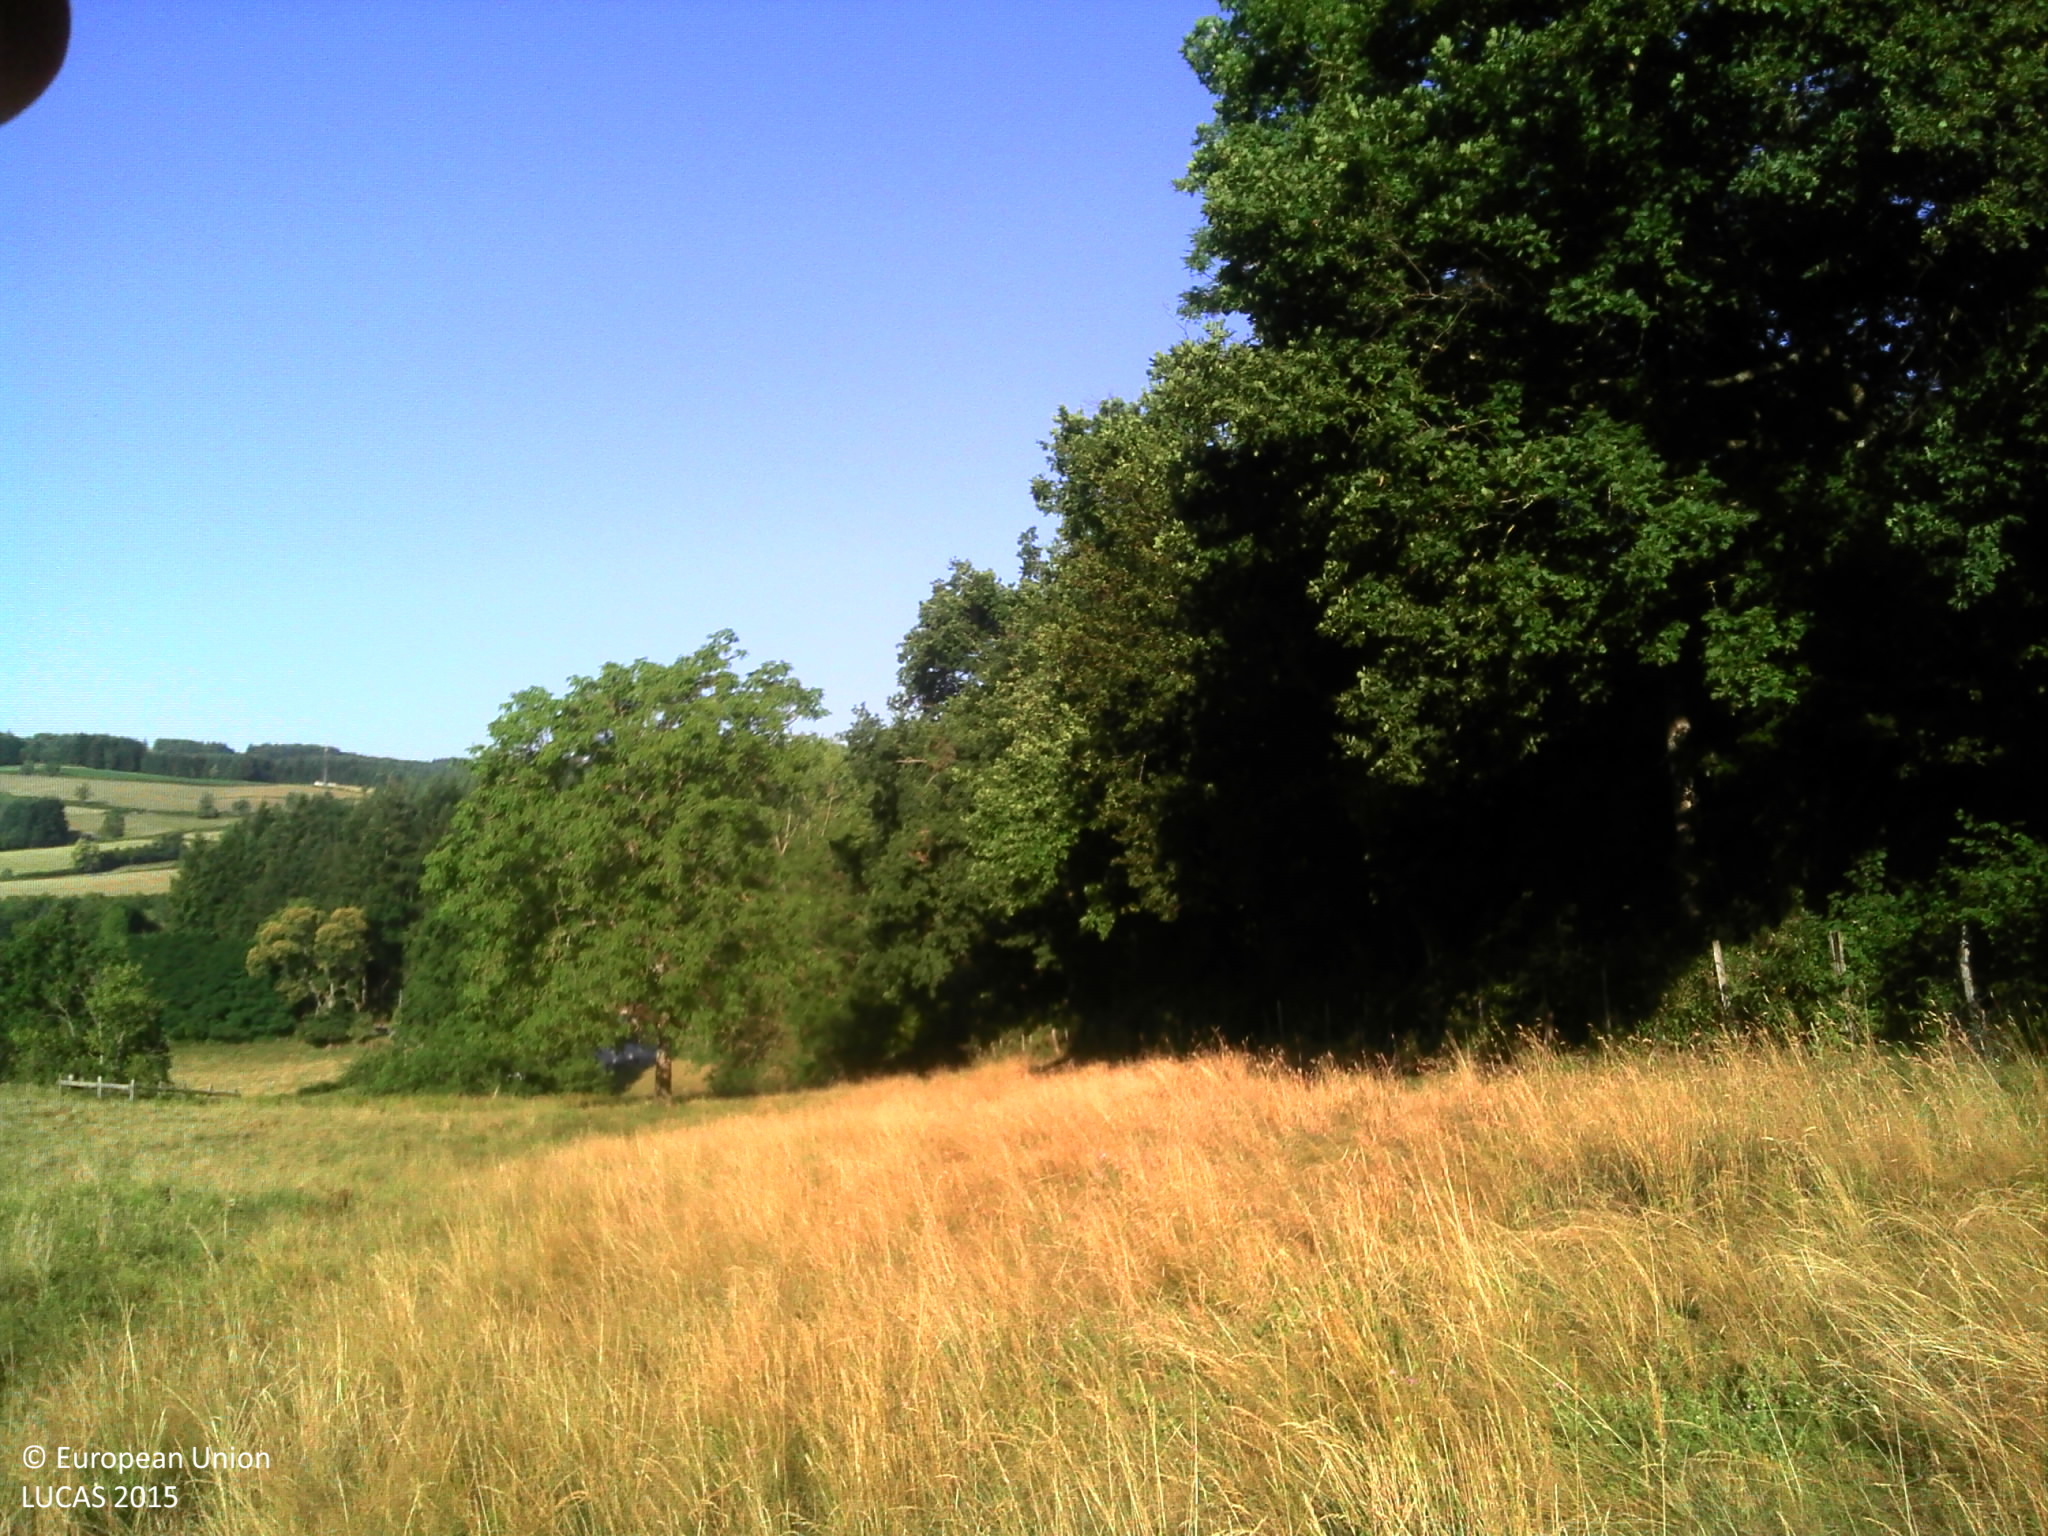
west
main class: Grassland
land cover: Grassland without tree/shrub cover
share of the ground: > 75 %
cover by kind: herbaceous plants 100 %
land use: Agriculture (excluding fallow land and kitchen gardens)
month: June
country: FR
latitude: 46.3889
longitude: 4.4749
